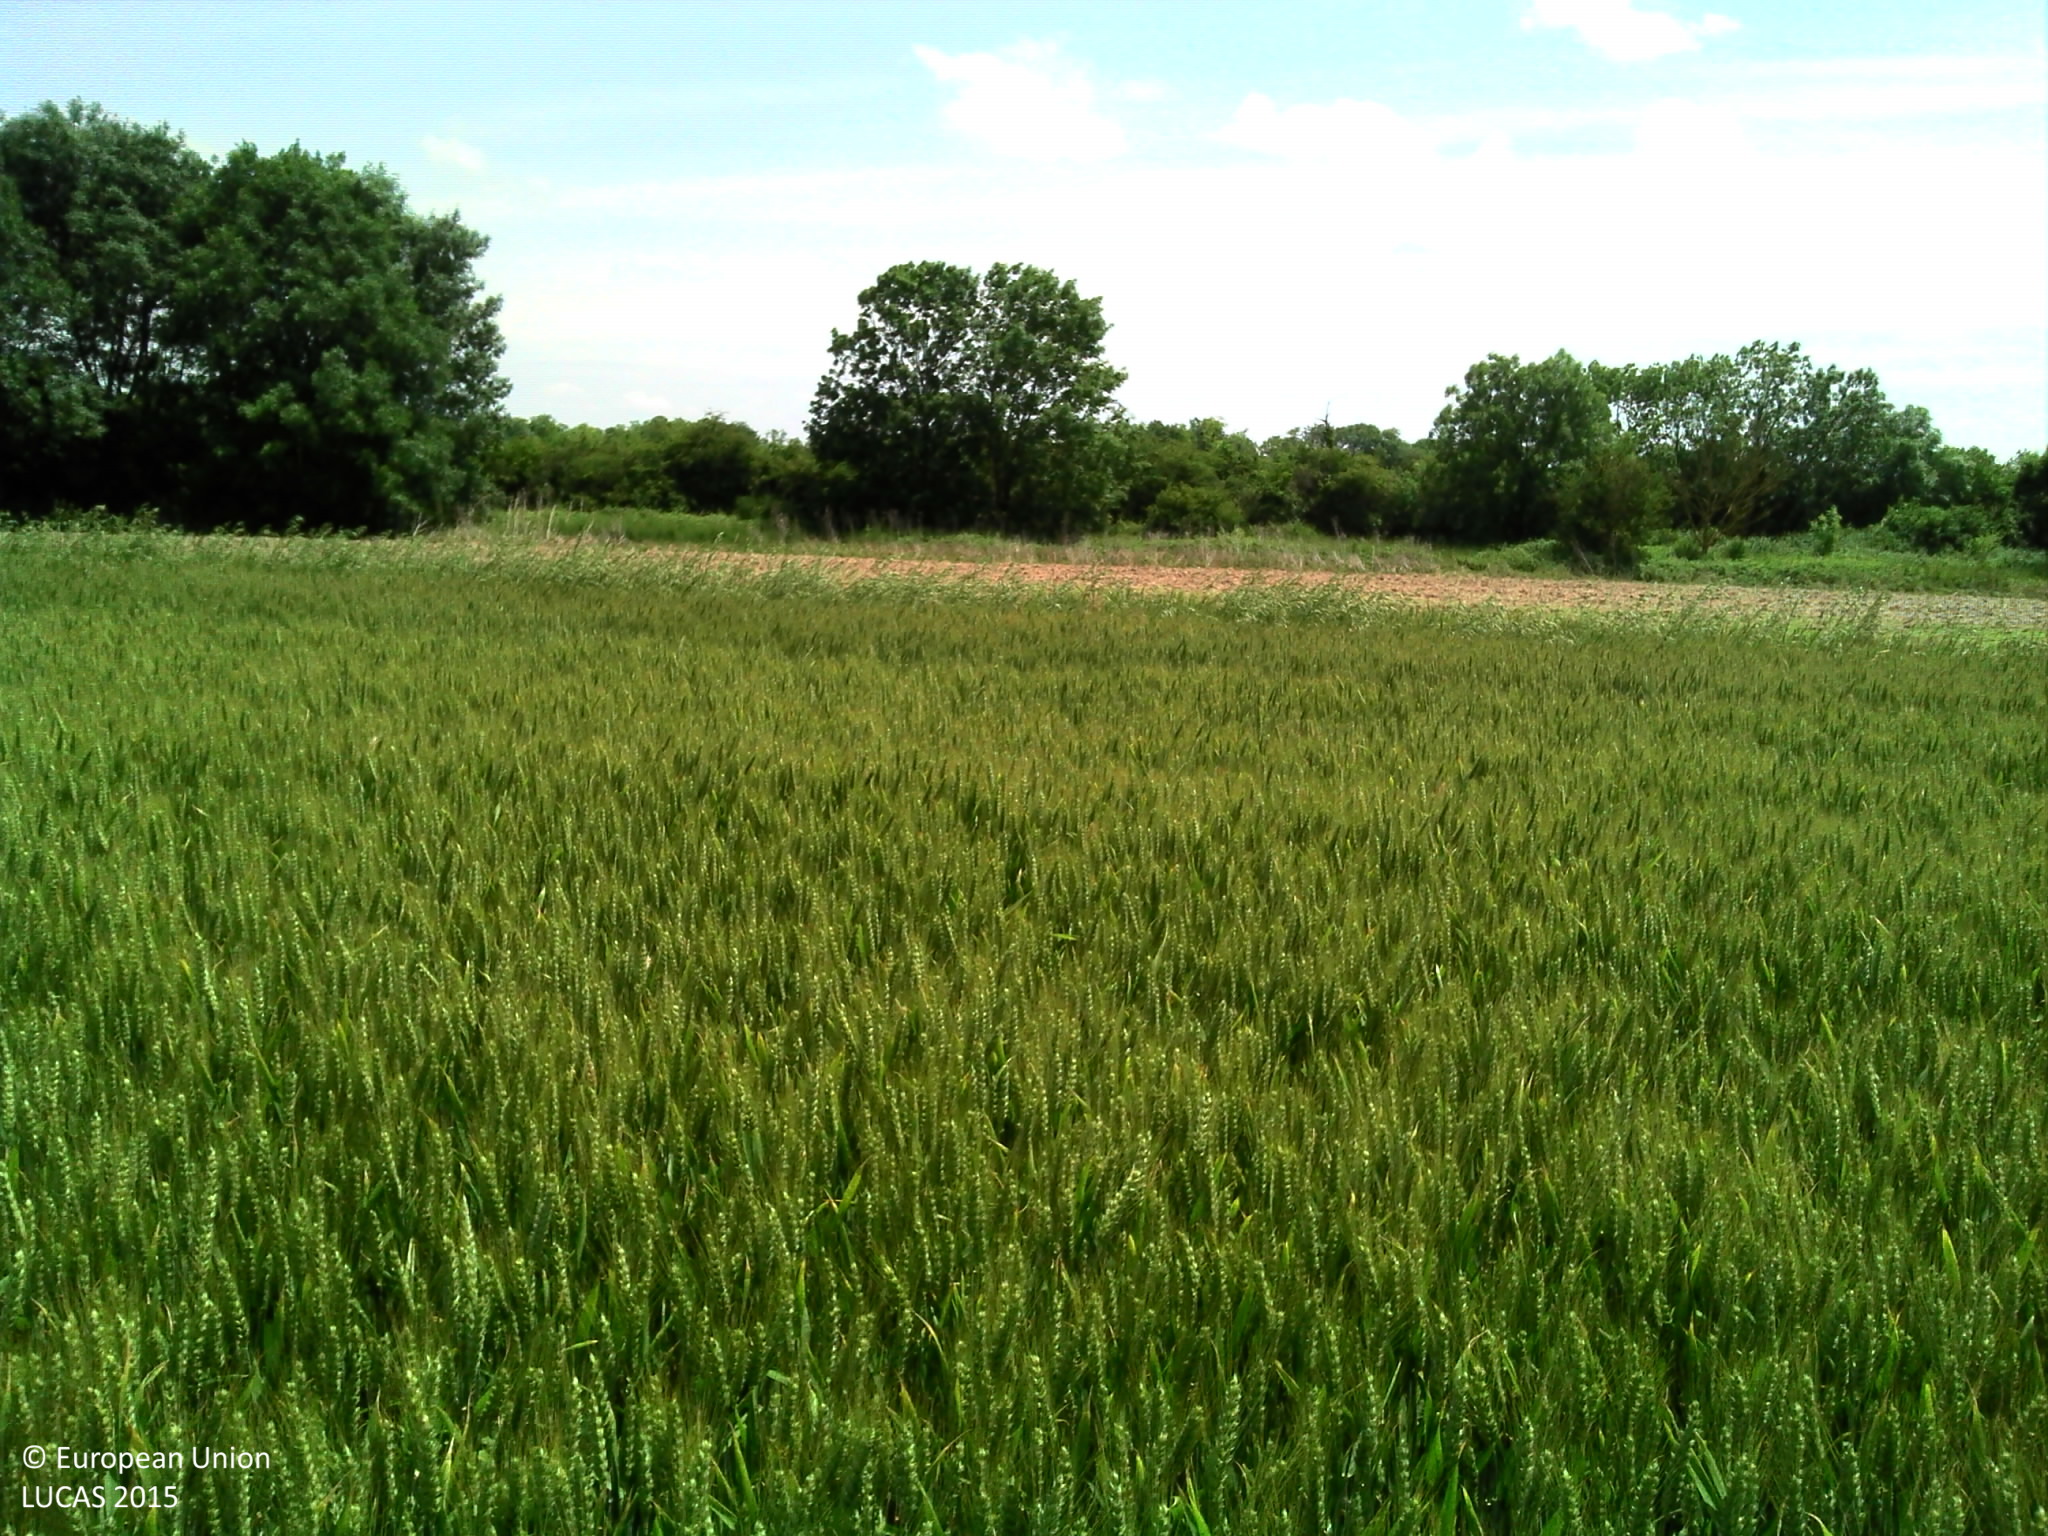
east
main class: Cropland
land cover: Common wheat
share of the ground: > 75 %
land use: Agriculture (excluding fallow land and kitchen gardens)
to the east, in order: Common wheat; Other bare soil; Broadleaved woodland; Tracks; Inland fresh running water; Broadleaved woodland; Rape and turnip rape
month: June
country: FR
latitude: 46.9497
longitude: 2.6761
